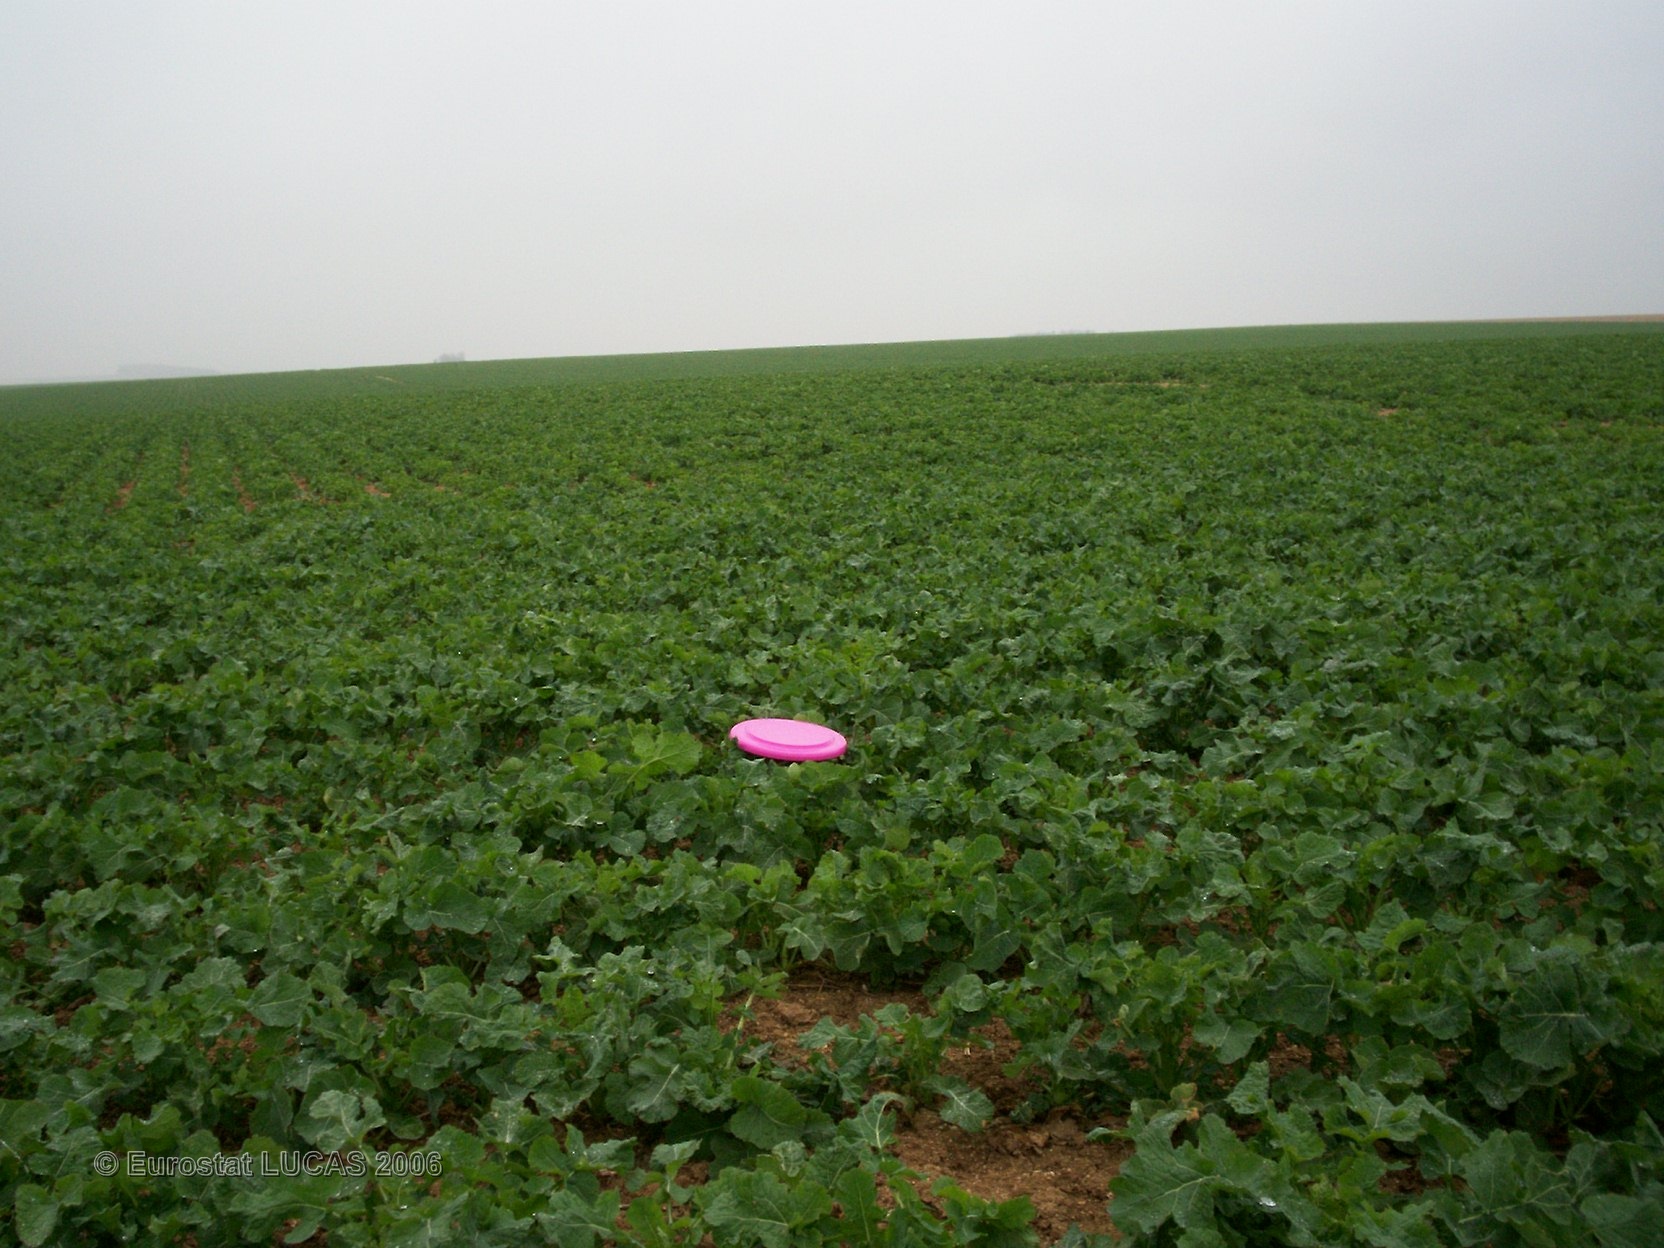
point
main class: Cropland
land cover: Rape and turnip rape
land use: Agriculture (excluding fallow land and kitchen gardens)
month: April
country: FR
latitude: 49.2451
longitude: 4.5982
